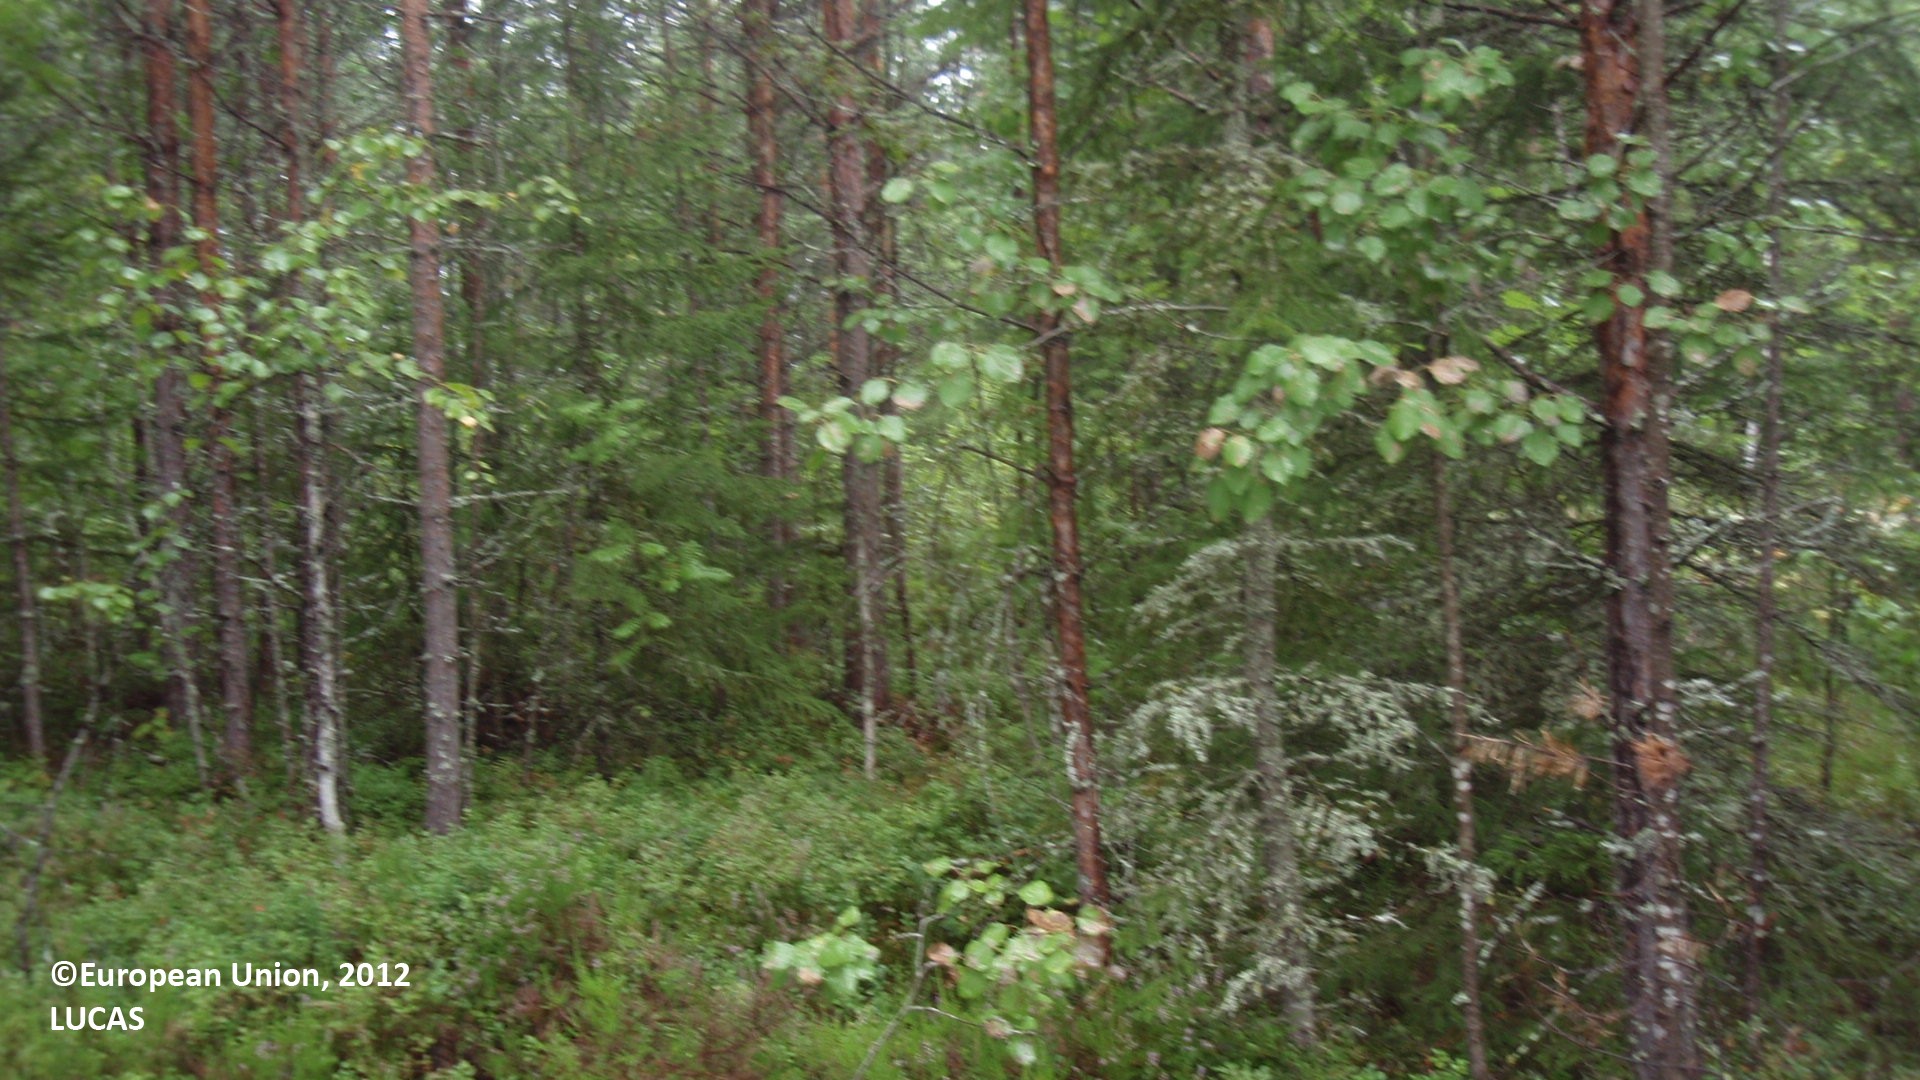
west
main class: Woodland
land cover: Pine dominated mixed woodland
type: boreal forest
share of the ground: 50 - 75 %
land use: Forestry
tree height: > 5 m
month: August
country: FI
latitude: 60.8547
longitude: 26.8586
